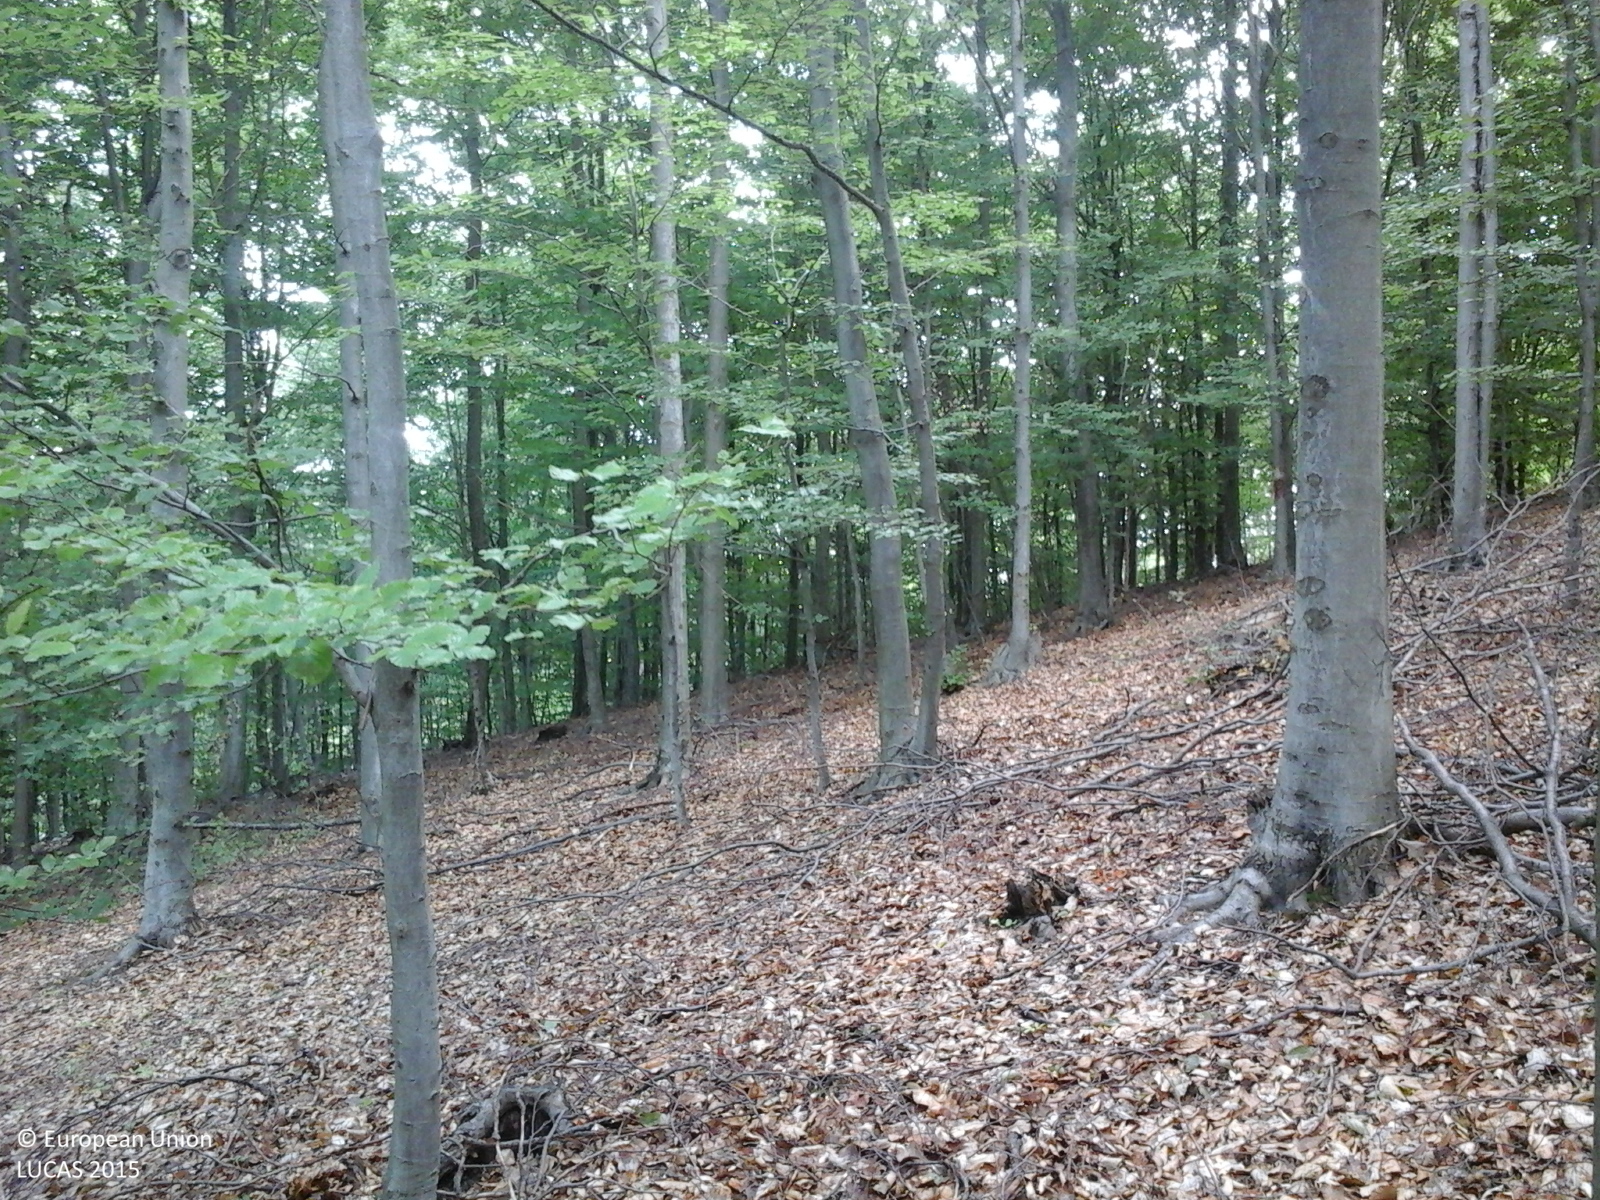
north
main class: Woodland
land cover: Broadleaved woodland
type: beech forest
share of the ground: > 75 %
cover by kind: broadleaved forest trees 100 %
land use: Forestry
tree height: > 5 m
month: June
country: RO
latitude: 47.0759
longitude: 26.4007
